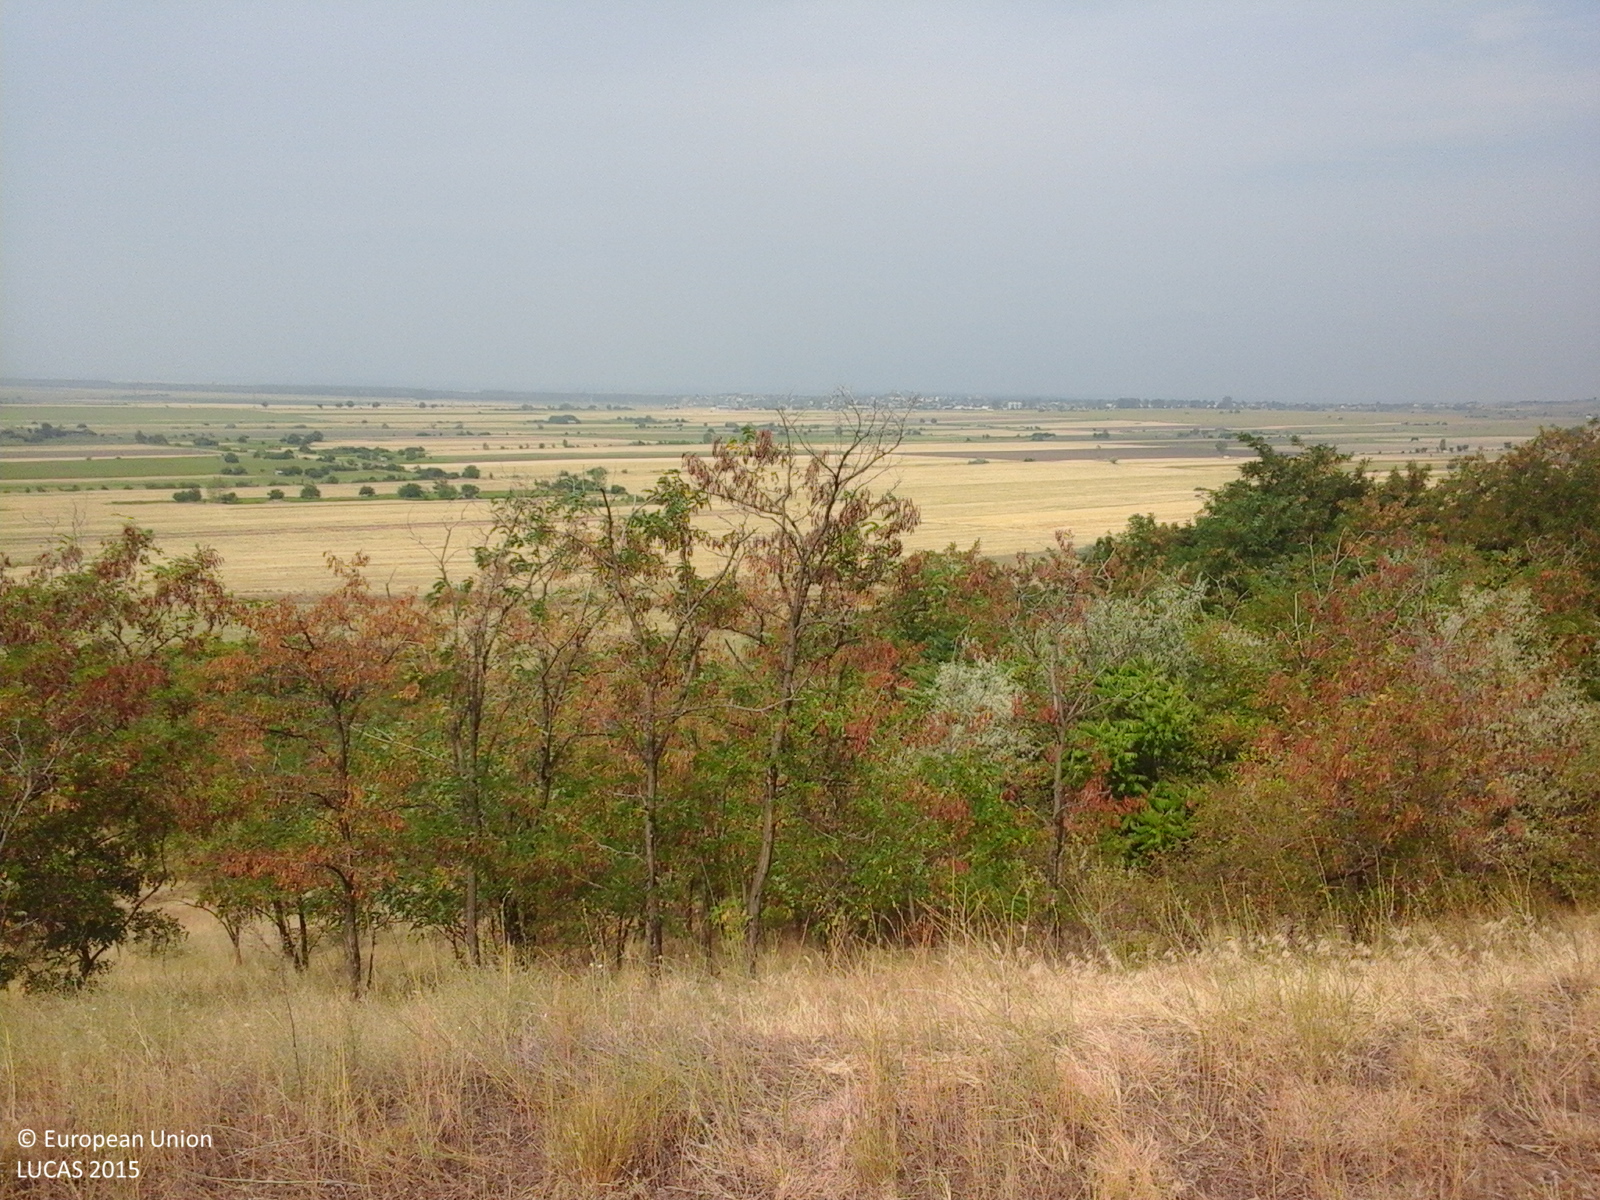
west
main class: Grassland
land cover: Grassland without tree/shrub cover
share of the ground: > 75 %
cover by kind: herbaceous plants 100 %
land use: Agriculture (excluding fallow land and kitchen gardens)
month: July
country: RO
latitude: 45.2344
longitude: 28.1964
